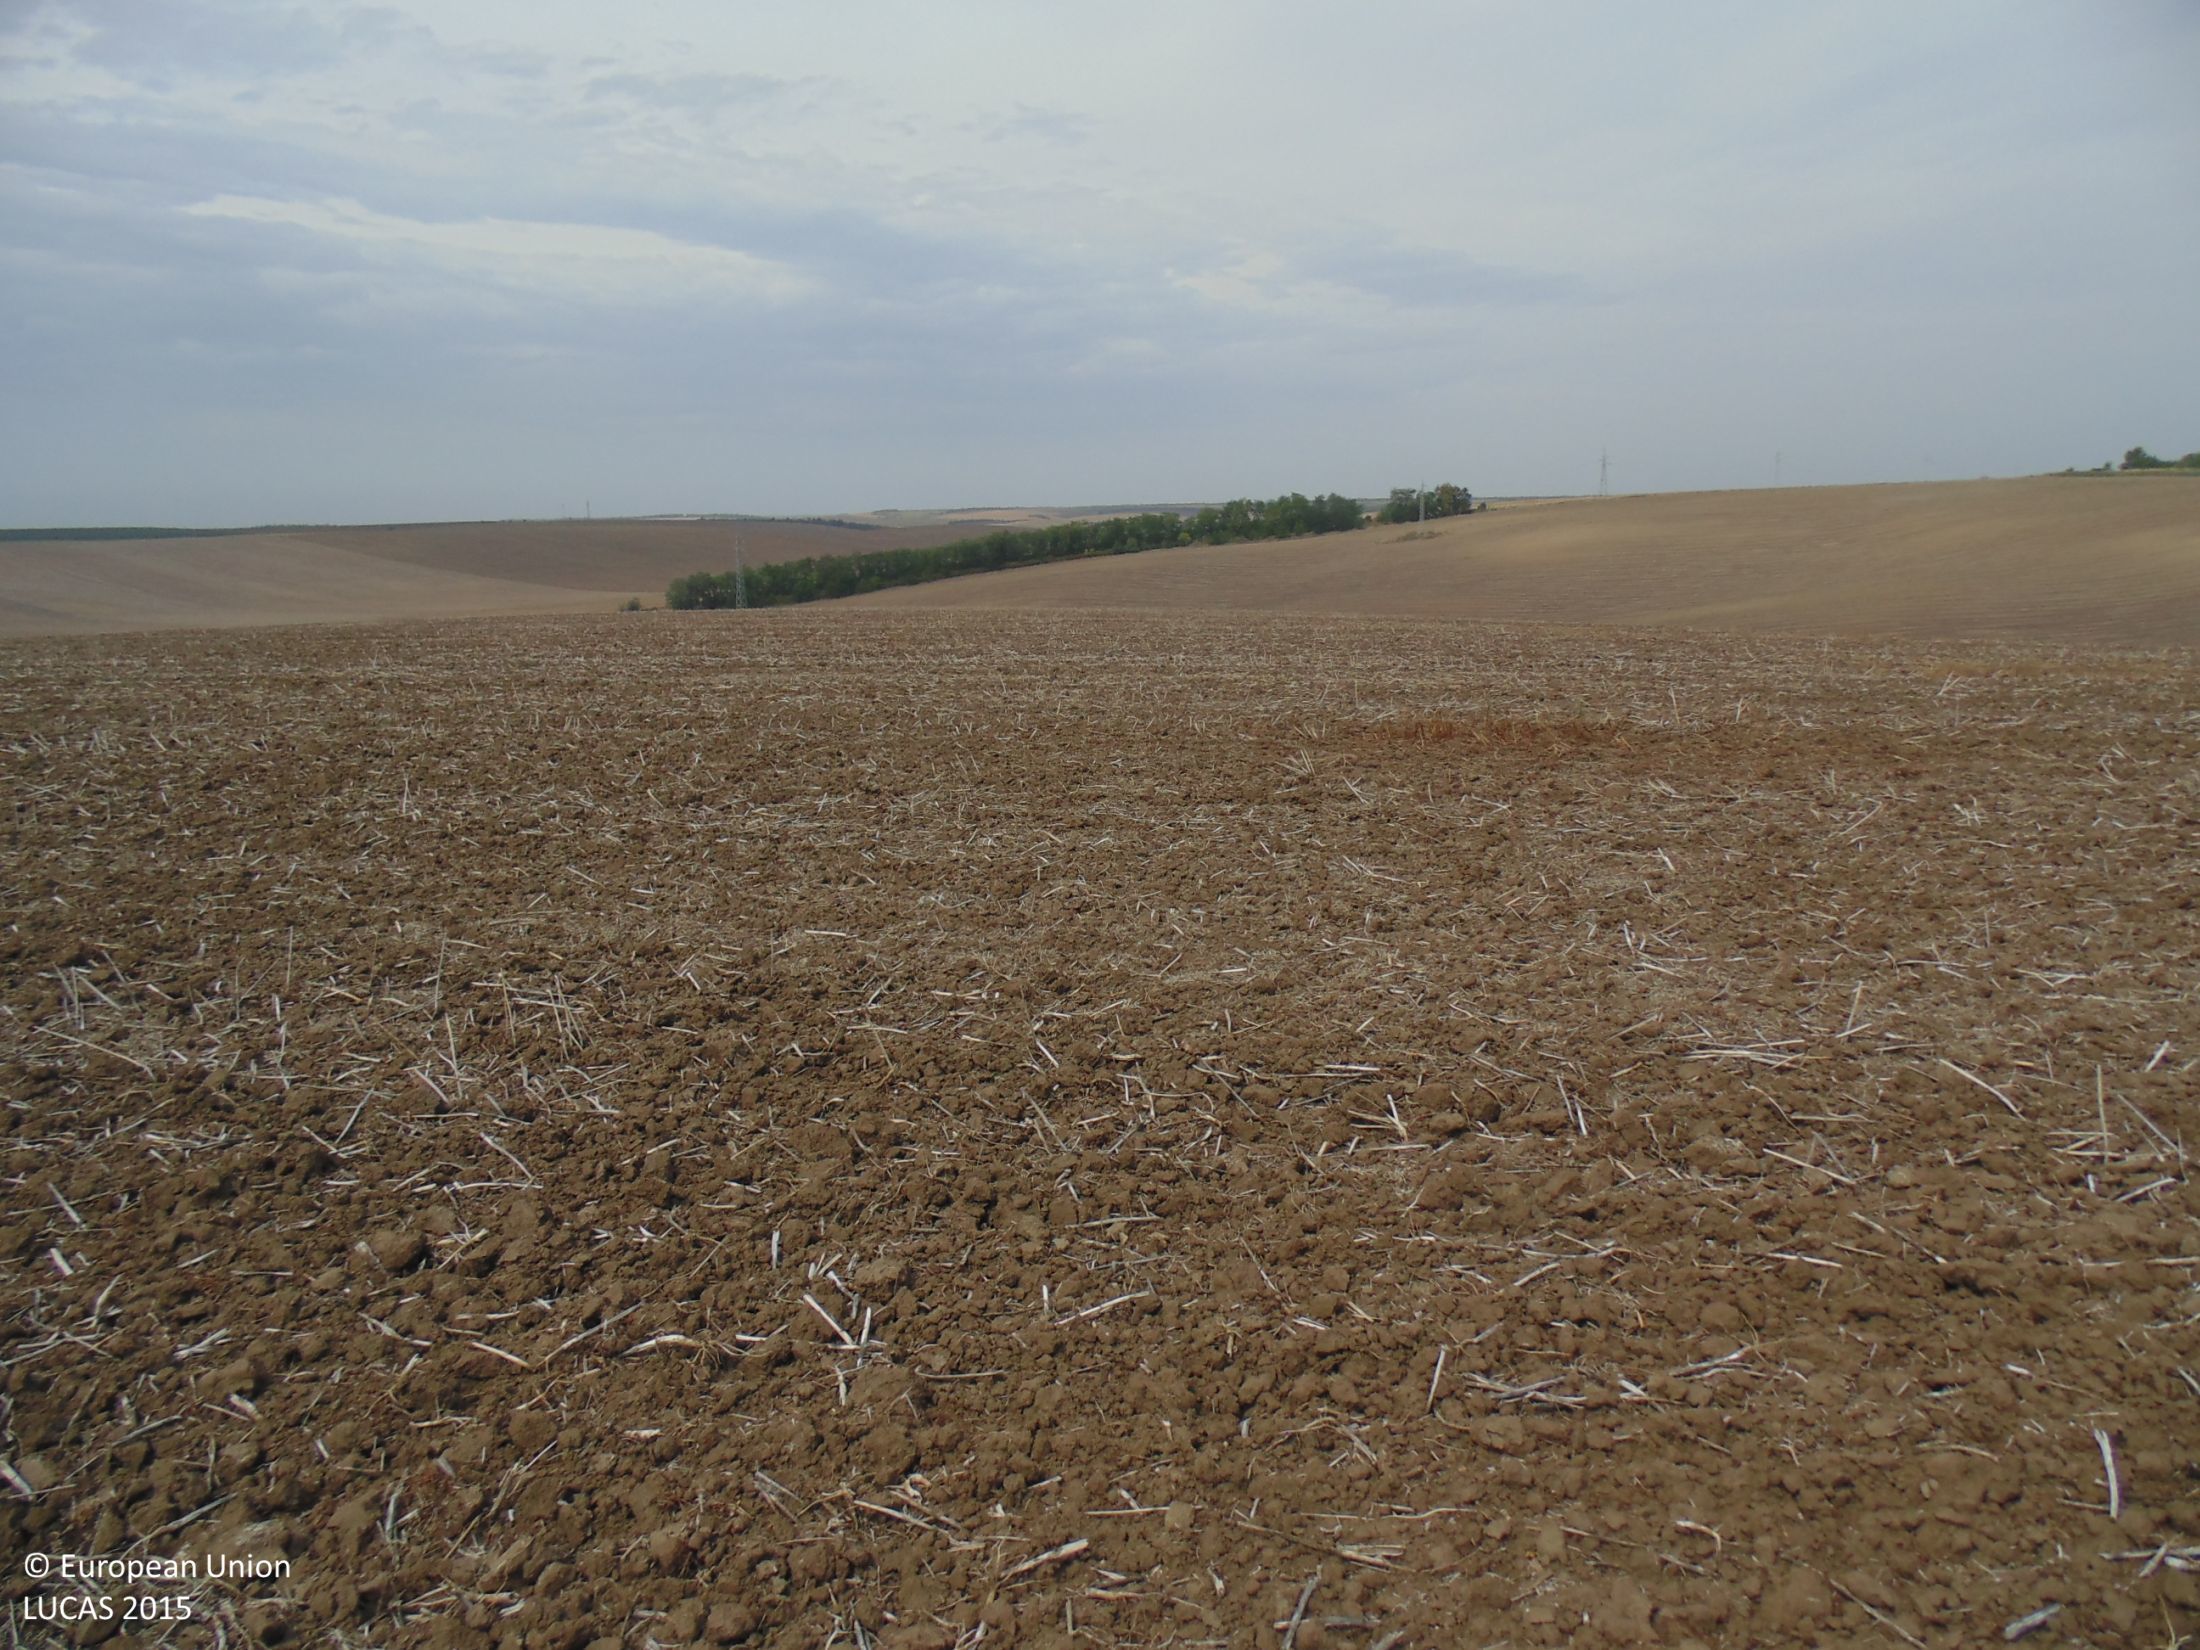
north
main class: Cropland
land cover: Rape and turnip rape
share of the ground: < 10 %
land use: Agriculture (excluding fallow land and kitchen gardens)
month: September
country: BG
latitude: 43.9877
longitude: 27.1976
